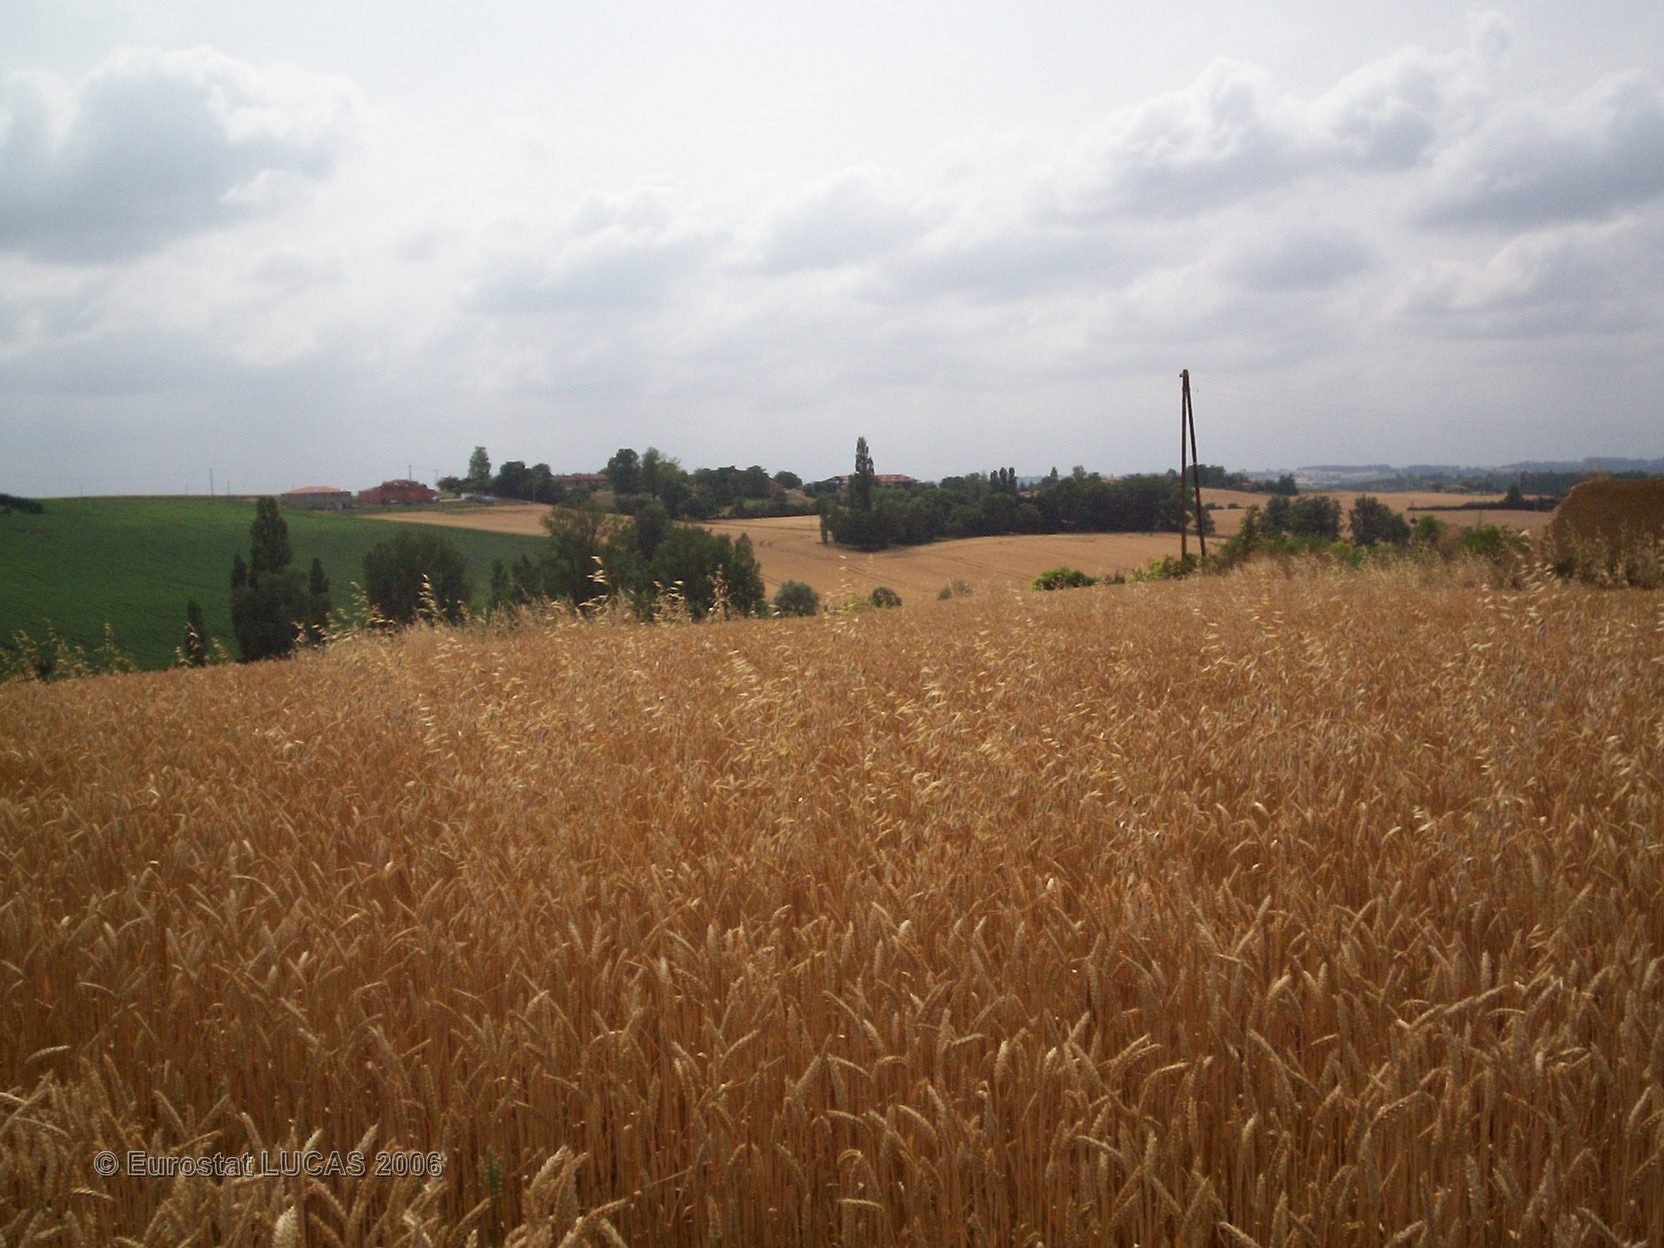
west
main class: Cropland
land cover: Common wheat
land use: Agriculture (excluding fallow land and kitchen gardens)
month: June
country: FR
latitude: 43.6893
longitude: 1.0303
